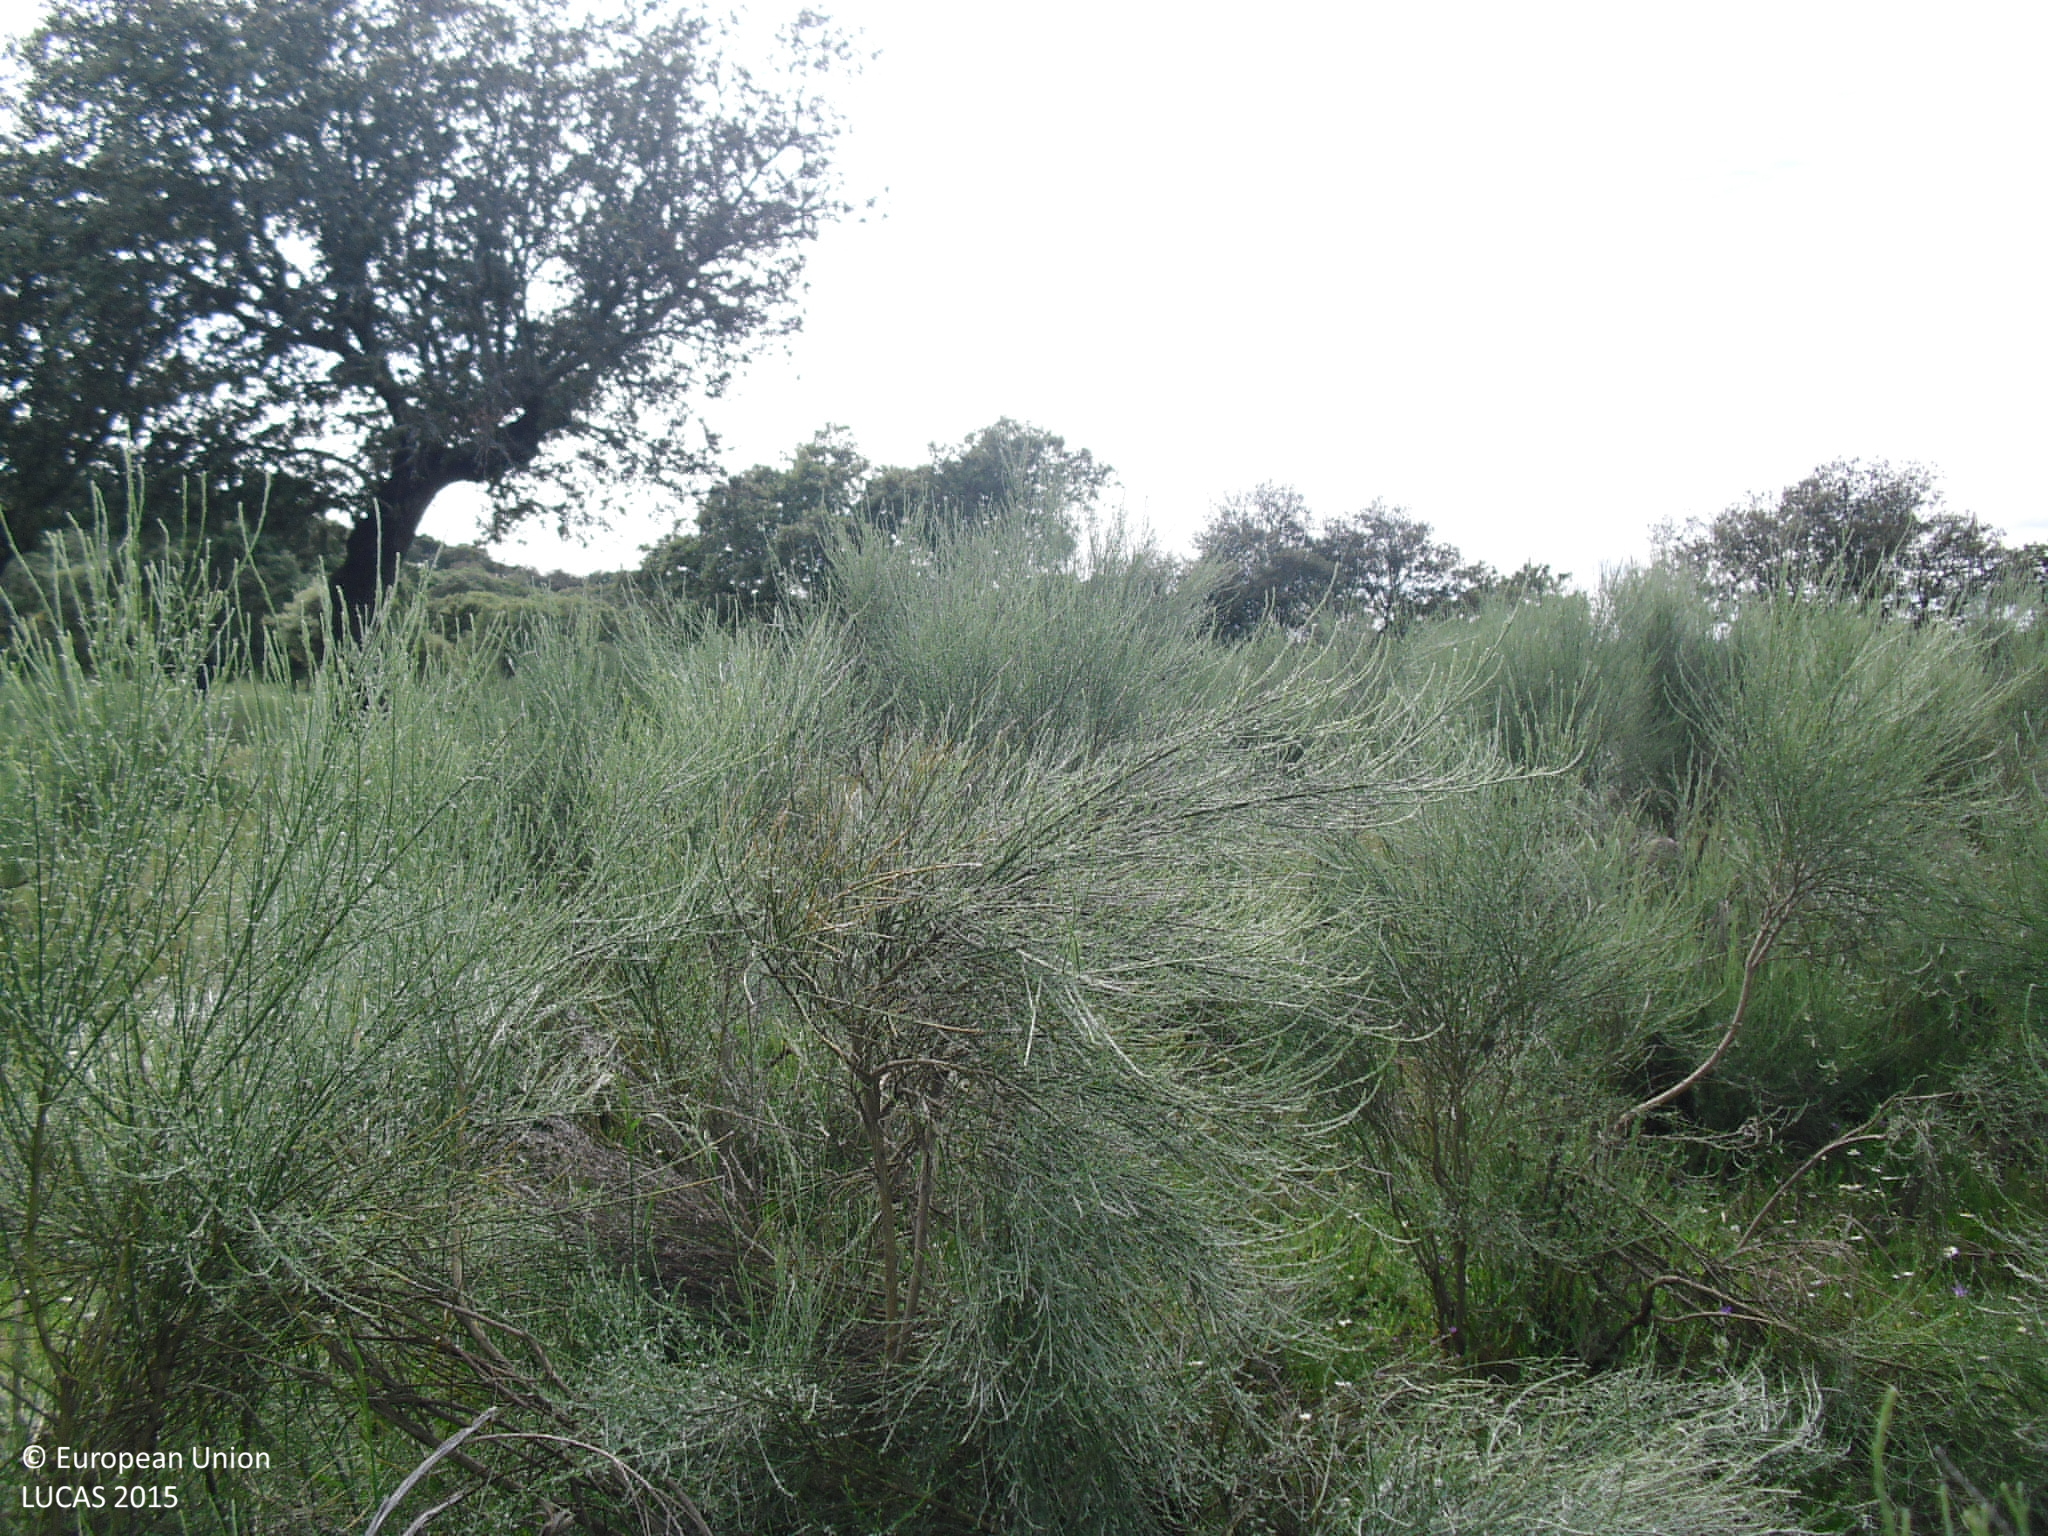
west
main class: Shrubland
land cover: Shrubland with sparse tree cover
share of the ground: > 75 %
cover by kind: shrubs 75 %, herbaceous plants 20 %, broadleaved forest trees 5 %
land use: Agriculture (excluding fallow land and kitchen gardens)
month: April
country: ES
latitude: 39.2942
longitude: -6.0005
